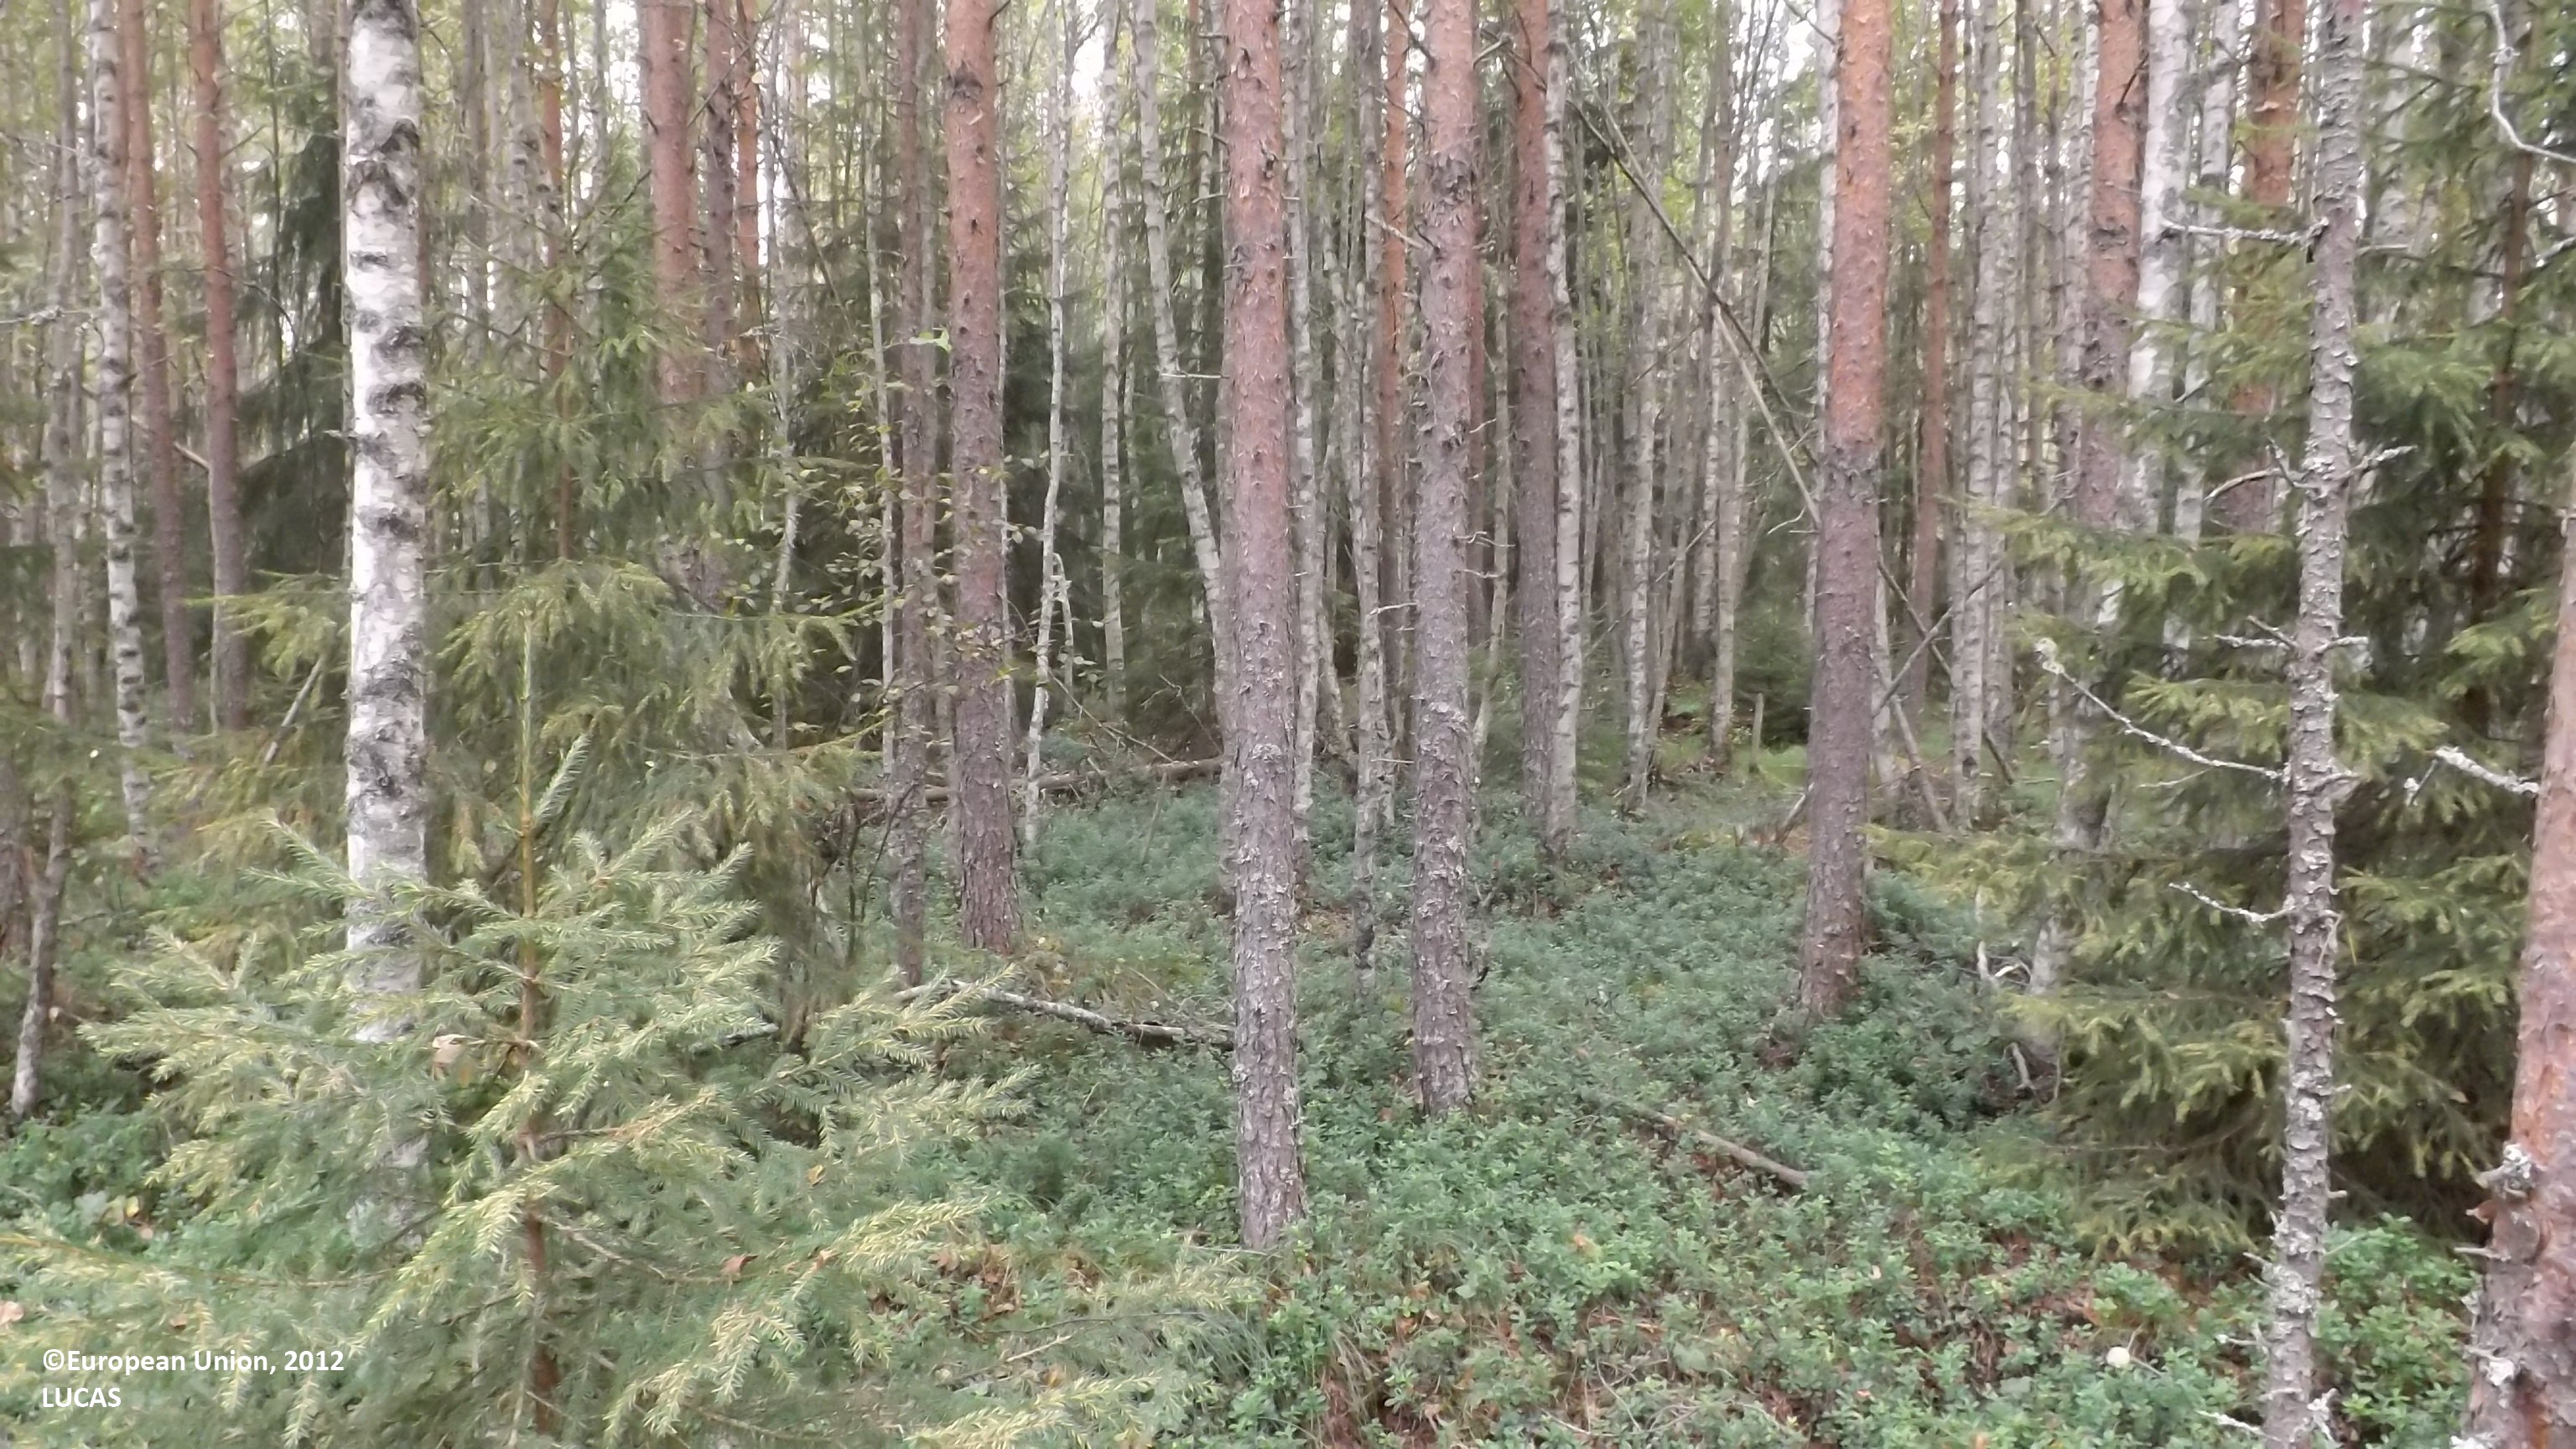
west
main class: Woodland
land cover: Pine dominated mixed woodland
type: boreal forest
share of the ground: > 75 %
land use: Forestry
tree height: > 5 m
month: August
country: FI
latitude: 63.8299
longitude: 23.5743
